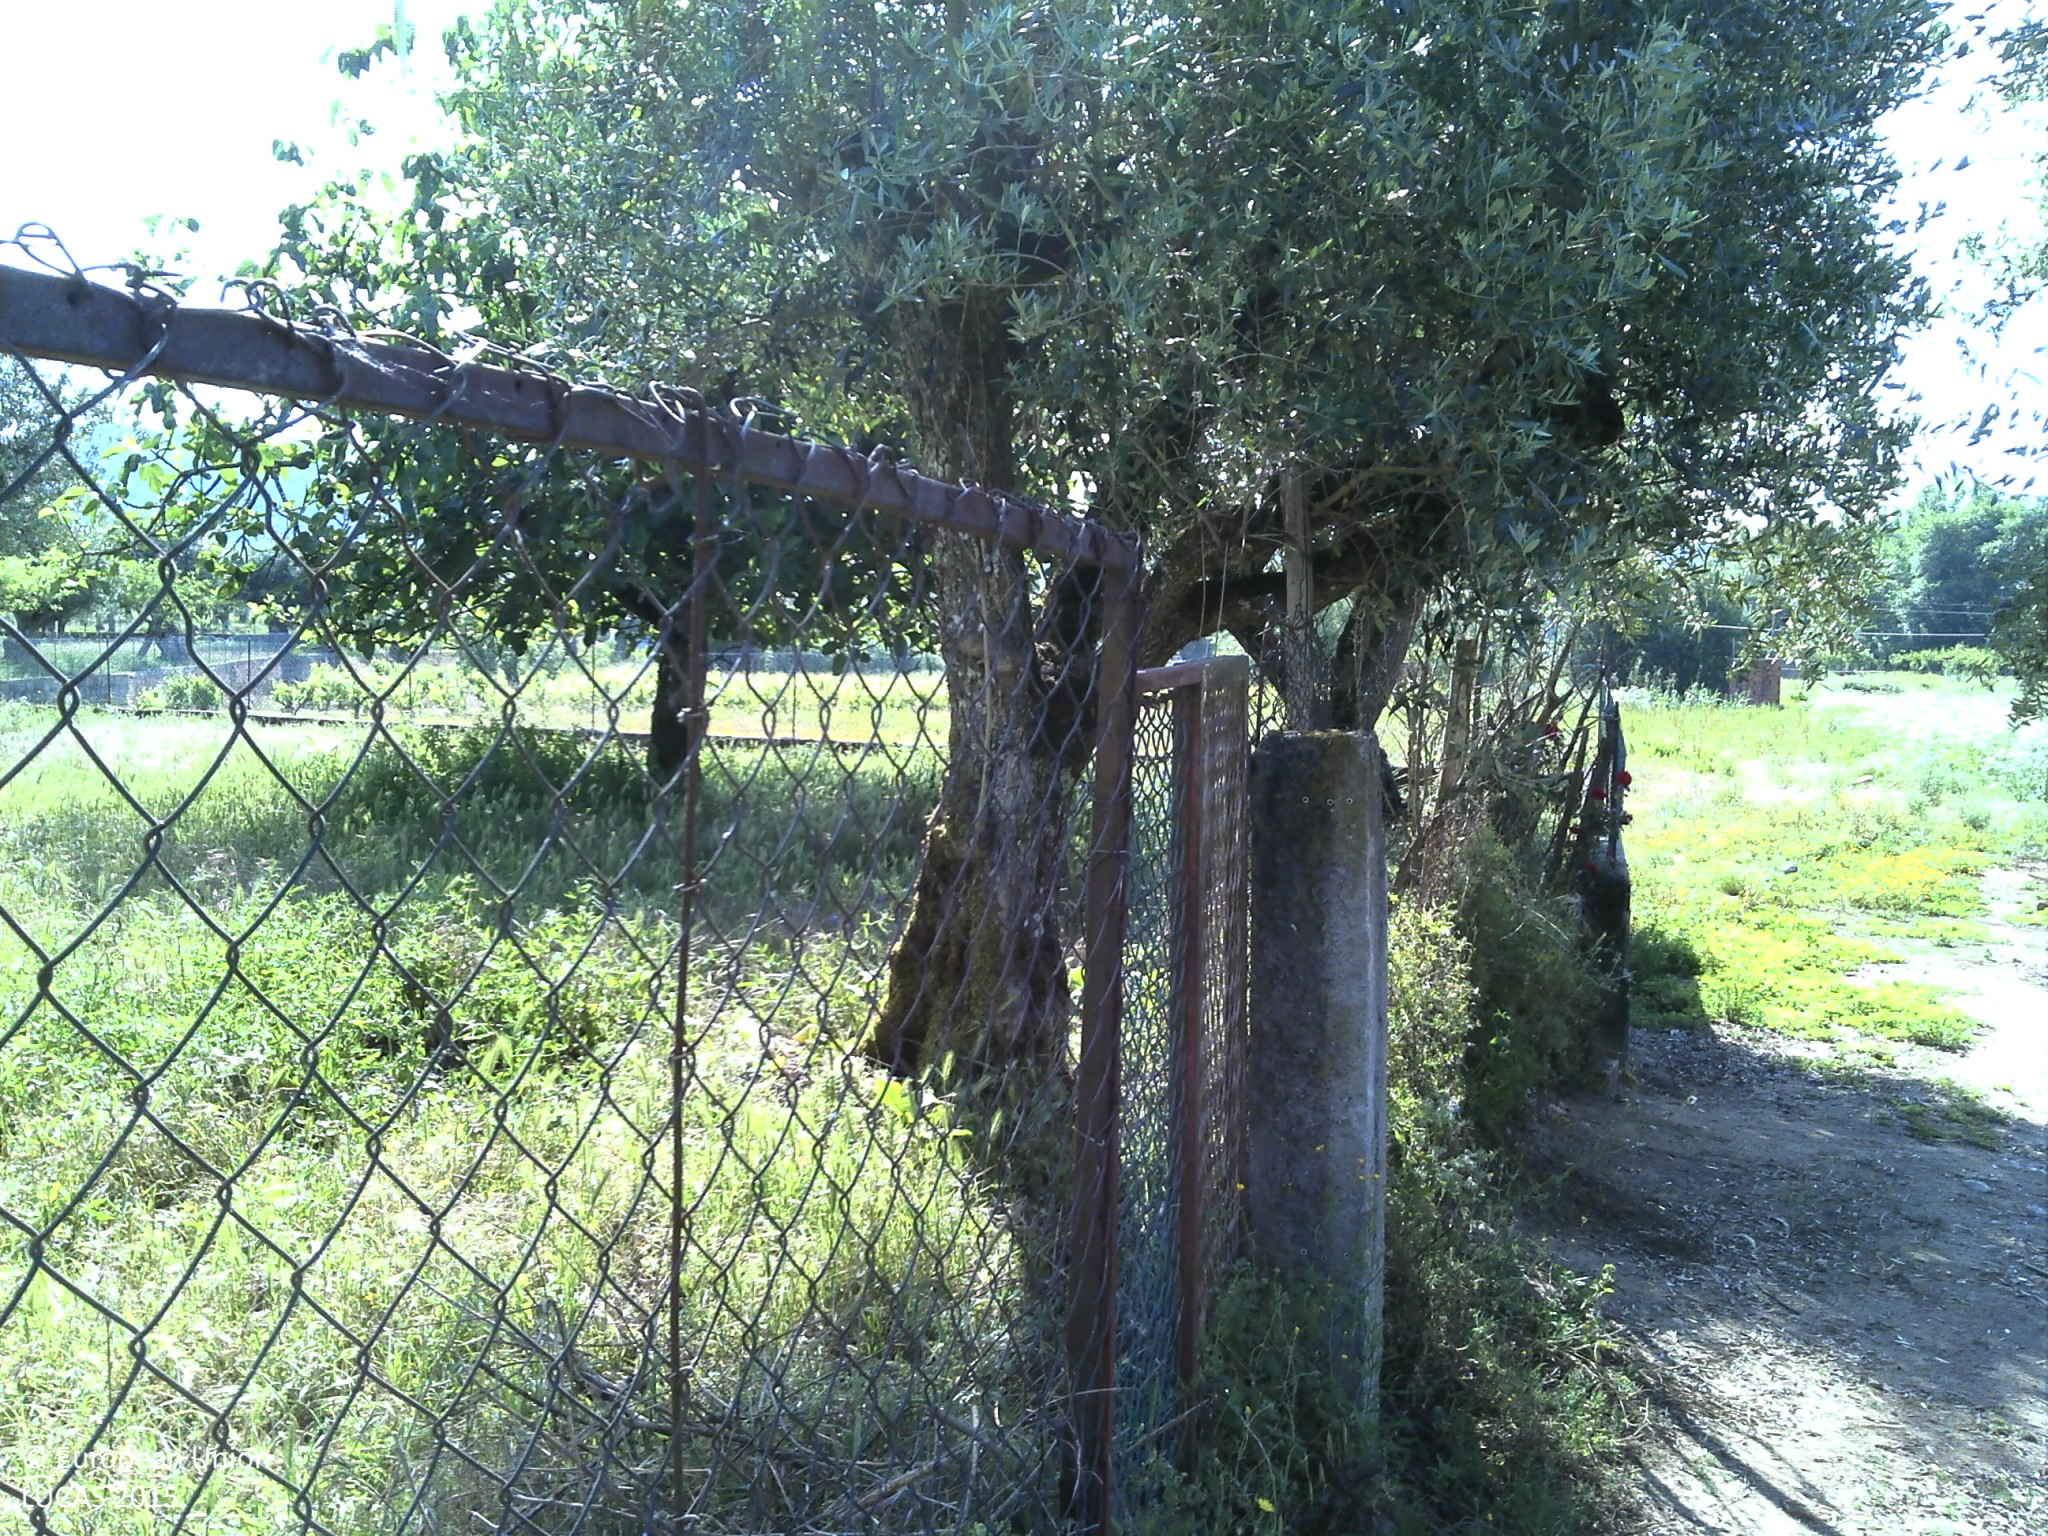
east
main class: Cropland
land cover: Potatoes
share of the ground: > 75 %
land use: Agriculture (excluding fallow land and kitchen gardens)
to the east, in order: Potatoes; Dry stone walls; Olive groves; Dry stone walls; Olive groves; Electric lines; Olive groves; Other fruit trees and berries; Electric lines; Other fruit trees and berries; Artificial constructions in urban areas; Olive groves; Fences; Abandoned hedges; Artificial constructions in urban areas
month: May
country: PT
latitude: 39.7565
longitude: -8.4595
